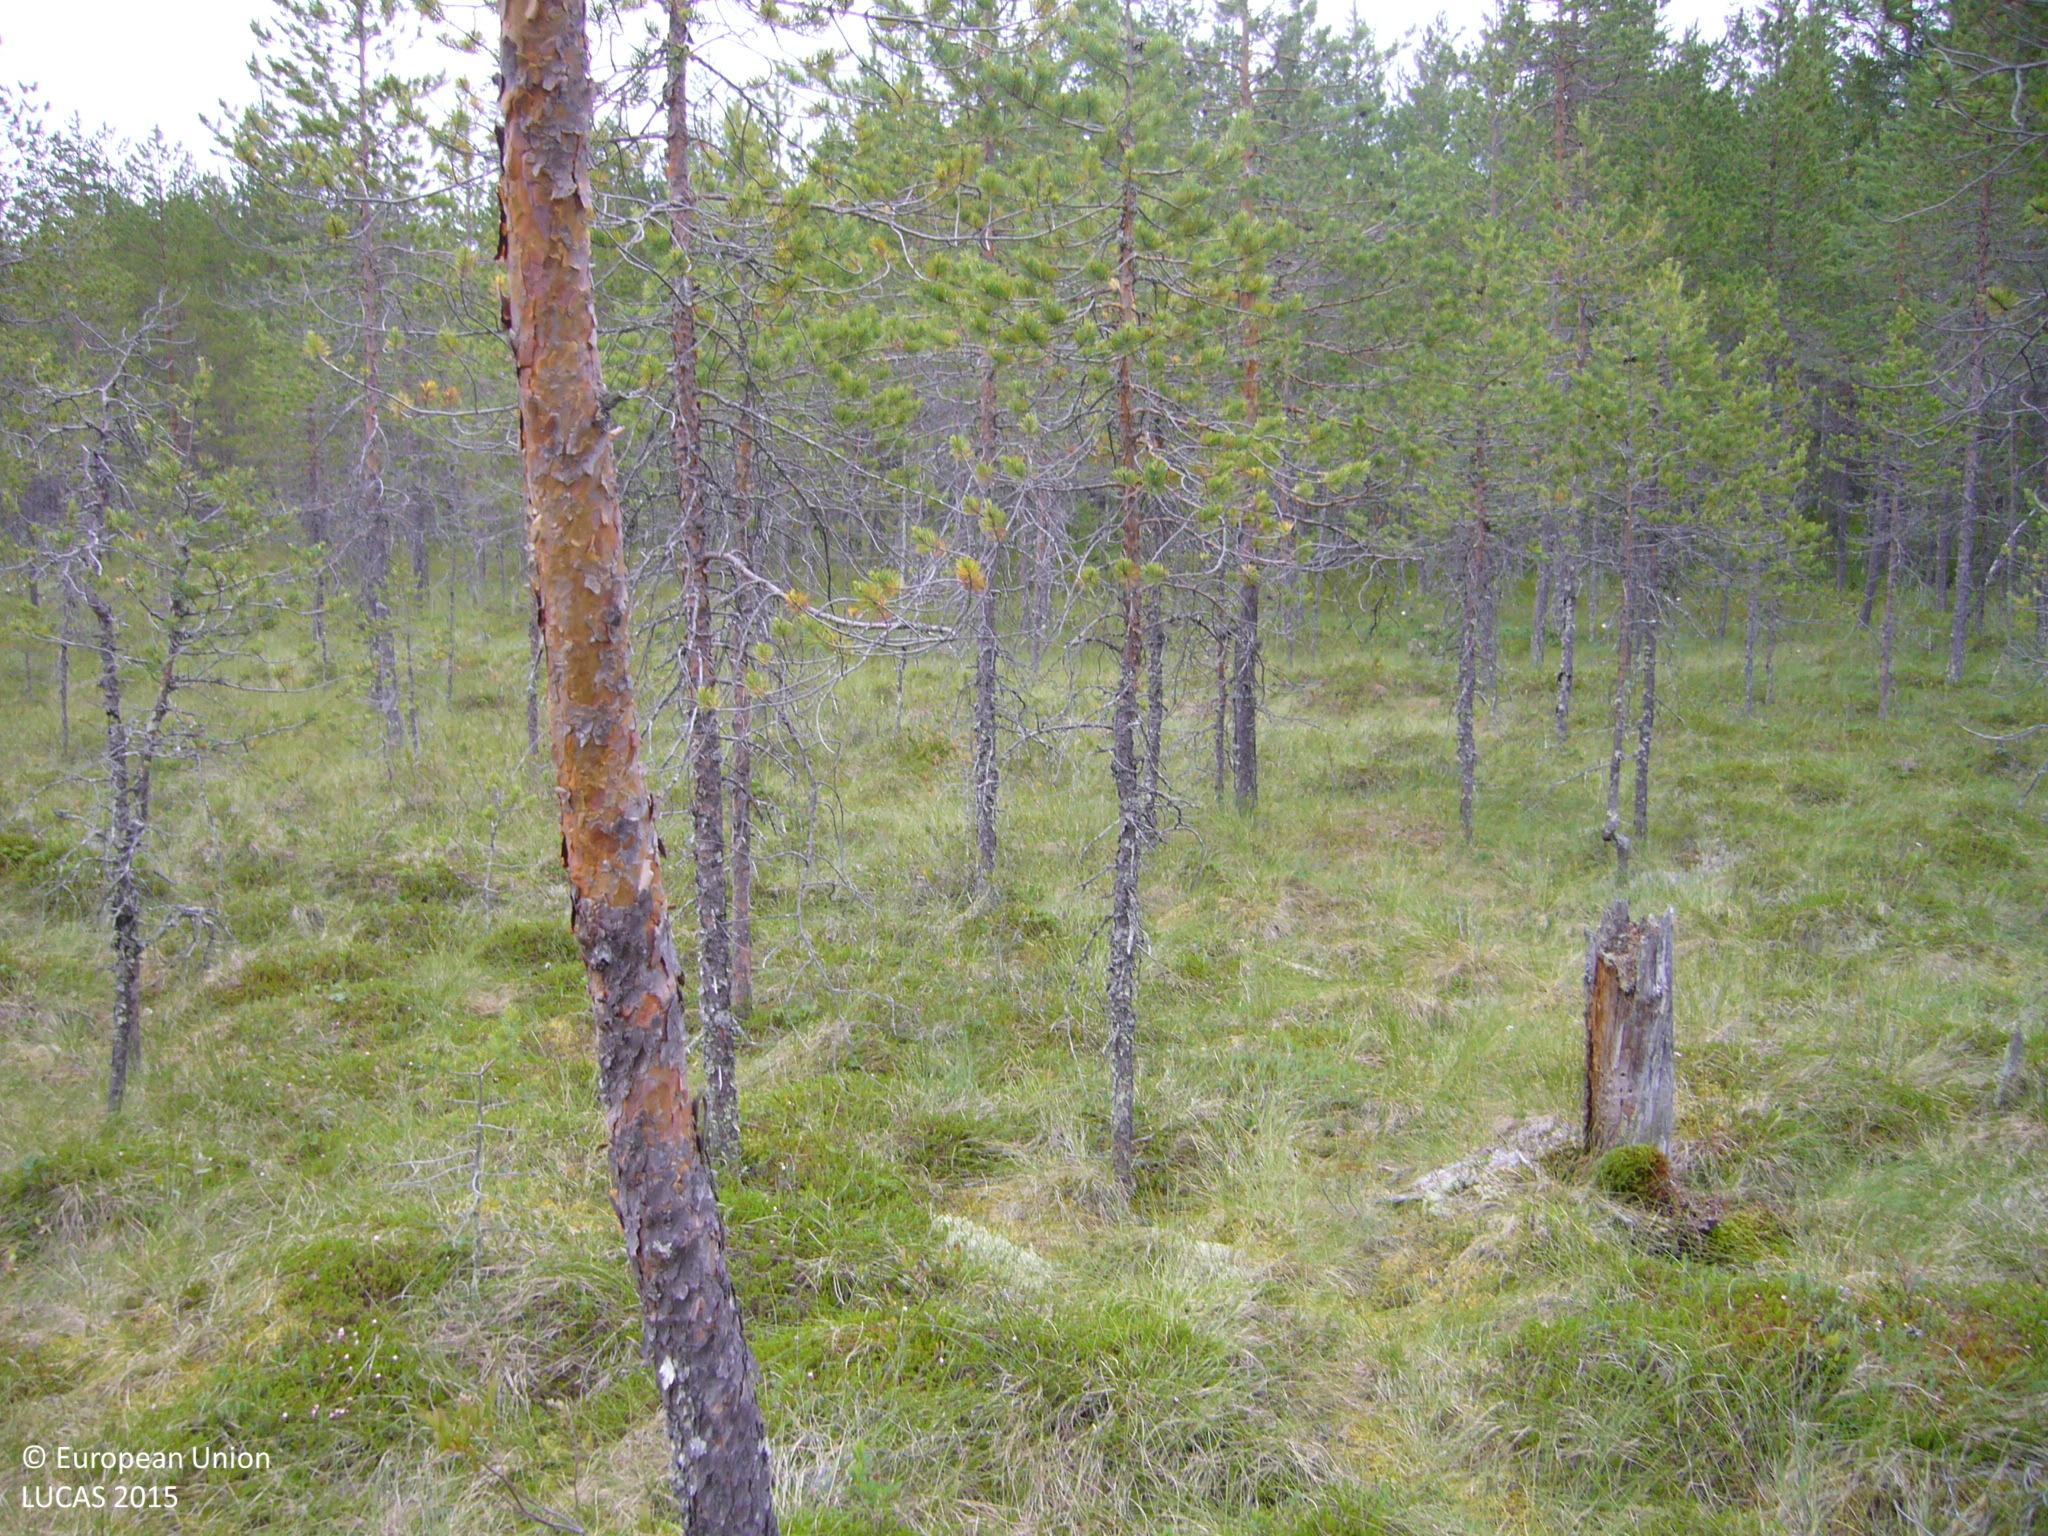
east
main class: Woodland
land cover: Pine dominated coniferous woodland
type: mire and swamp forests
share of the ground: 25 - 50 %
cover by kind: lichens and mosses 65 %, coniferous forest trees 25 %, herbaceous plants 10 %
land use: Semi-natural and natural areas not in use
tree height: < 5 m
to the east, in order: Pine dominated coniferous woodland
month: July
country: FI
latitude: 63.5119
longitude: 25.9273
